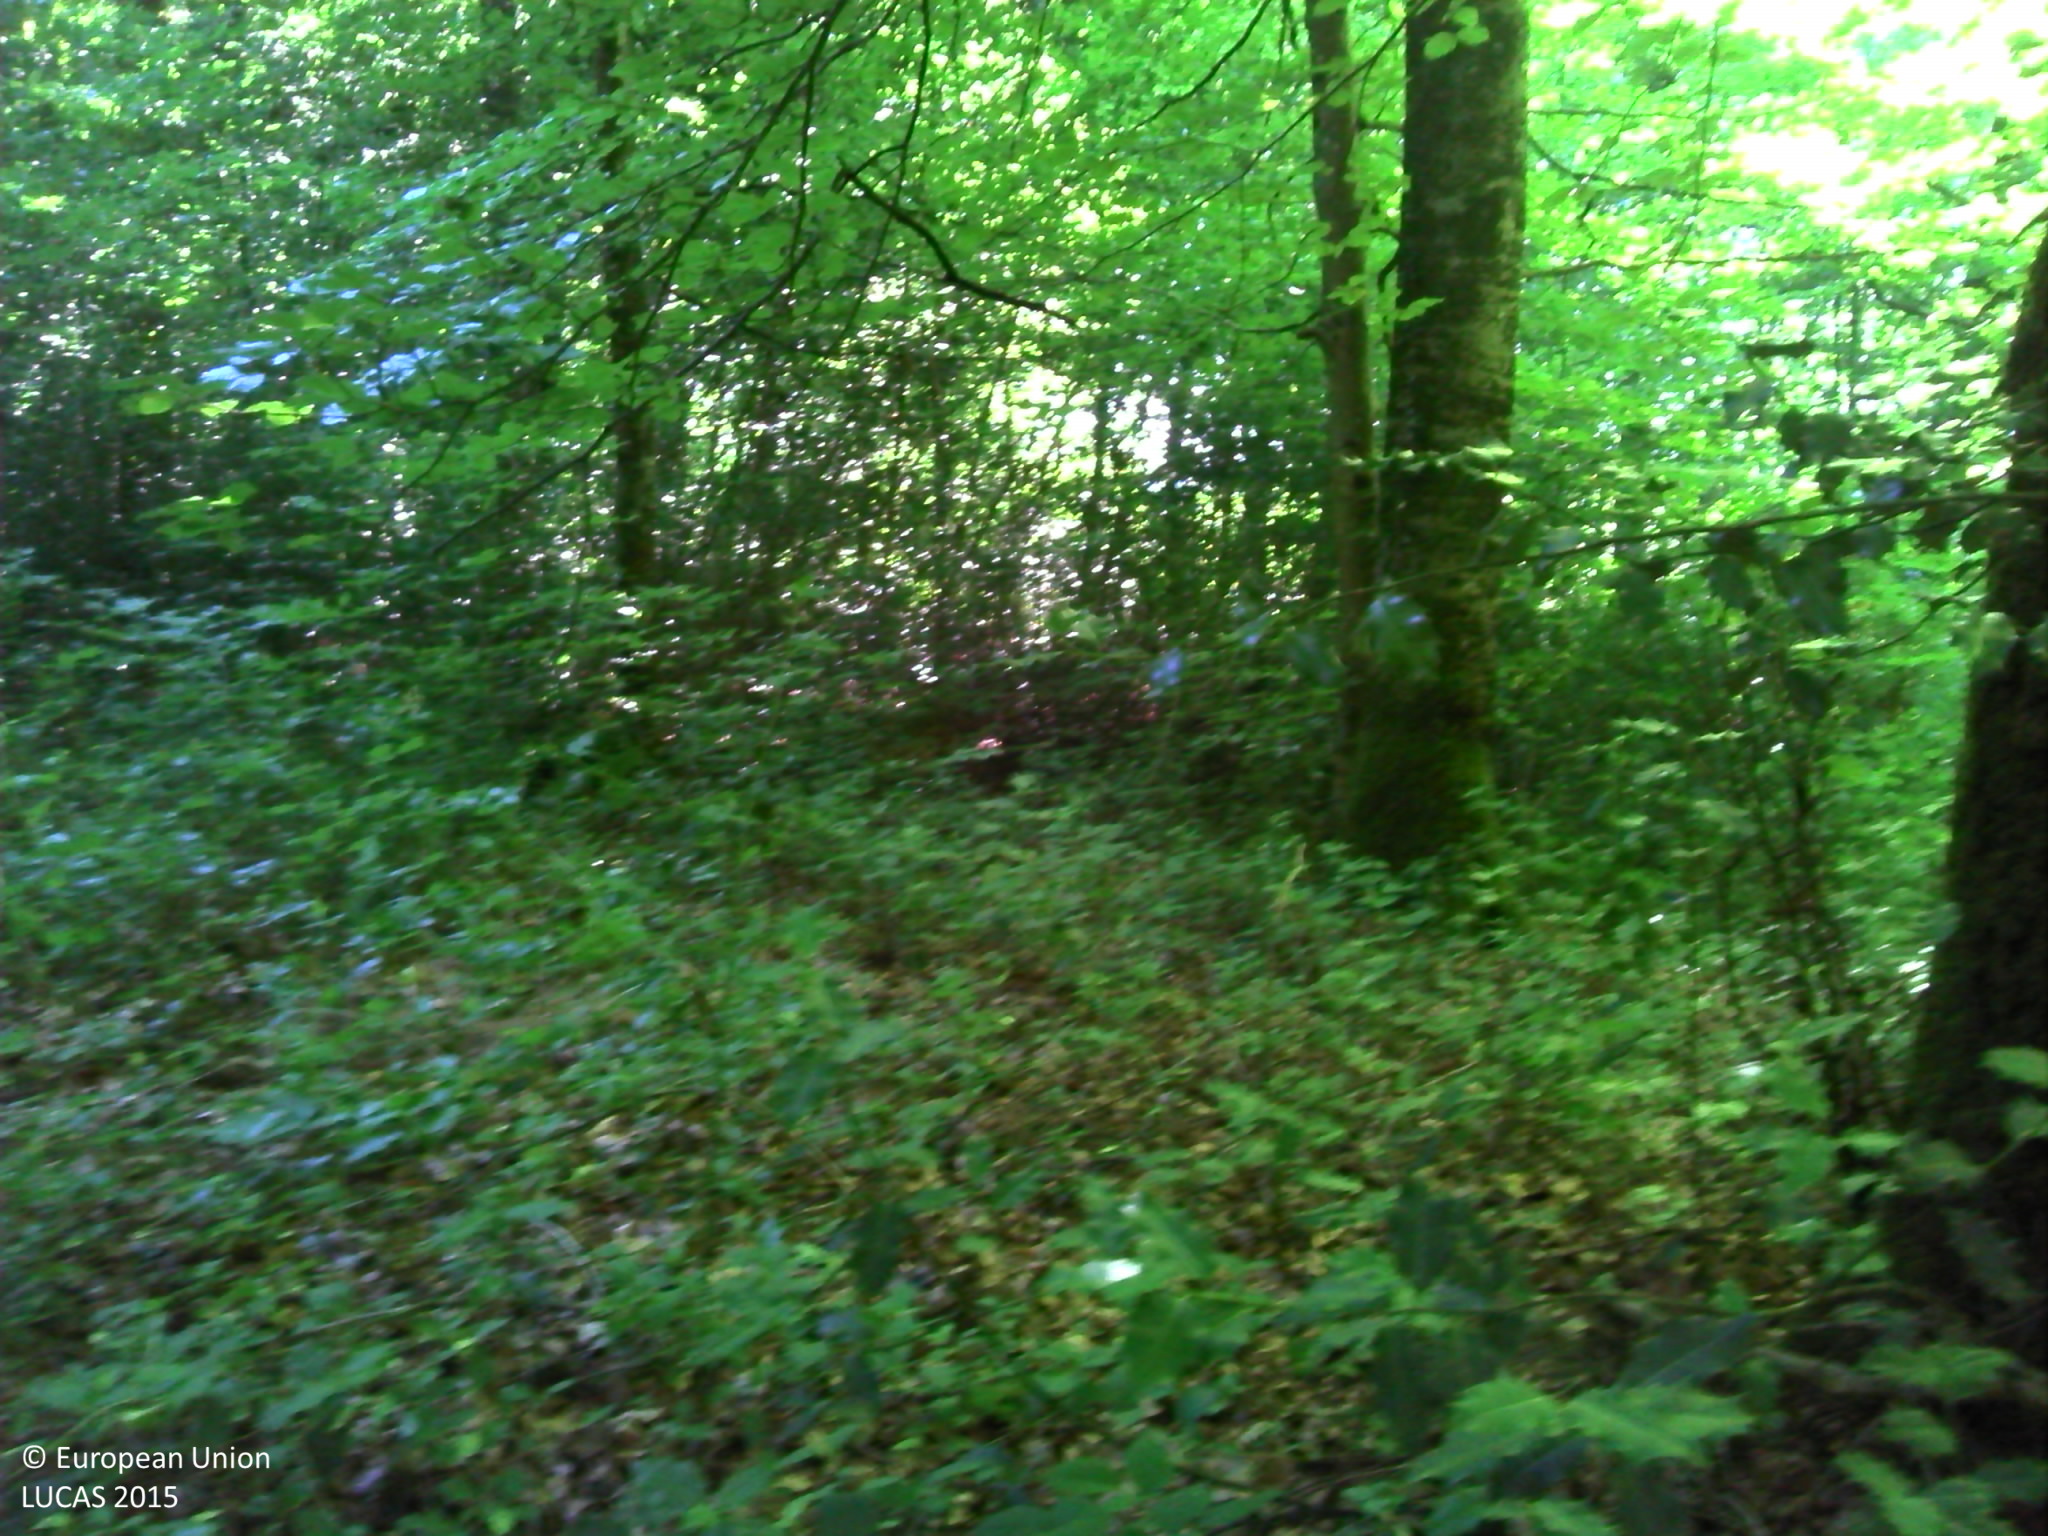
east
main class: Woodland
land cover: Broadleaved woodland
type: beech forest
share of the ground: > 75 %
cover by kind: broadleaved forest trees 95 %, herbaceous plants 5 %
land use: Forestry
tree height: > 5 m
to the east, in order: Broadleaved woodland; Fences; Broadleaved woodland; Artificial constructions in urban areas; Grassland without tree/shrub cover; Tracks; Nurseries; Other fruit trees and berries; Grassland without tree/shrub cover; Tracks; Other fresh vegetables
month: June
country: FR
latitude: 47.4174
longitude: 6.1445
